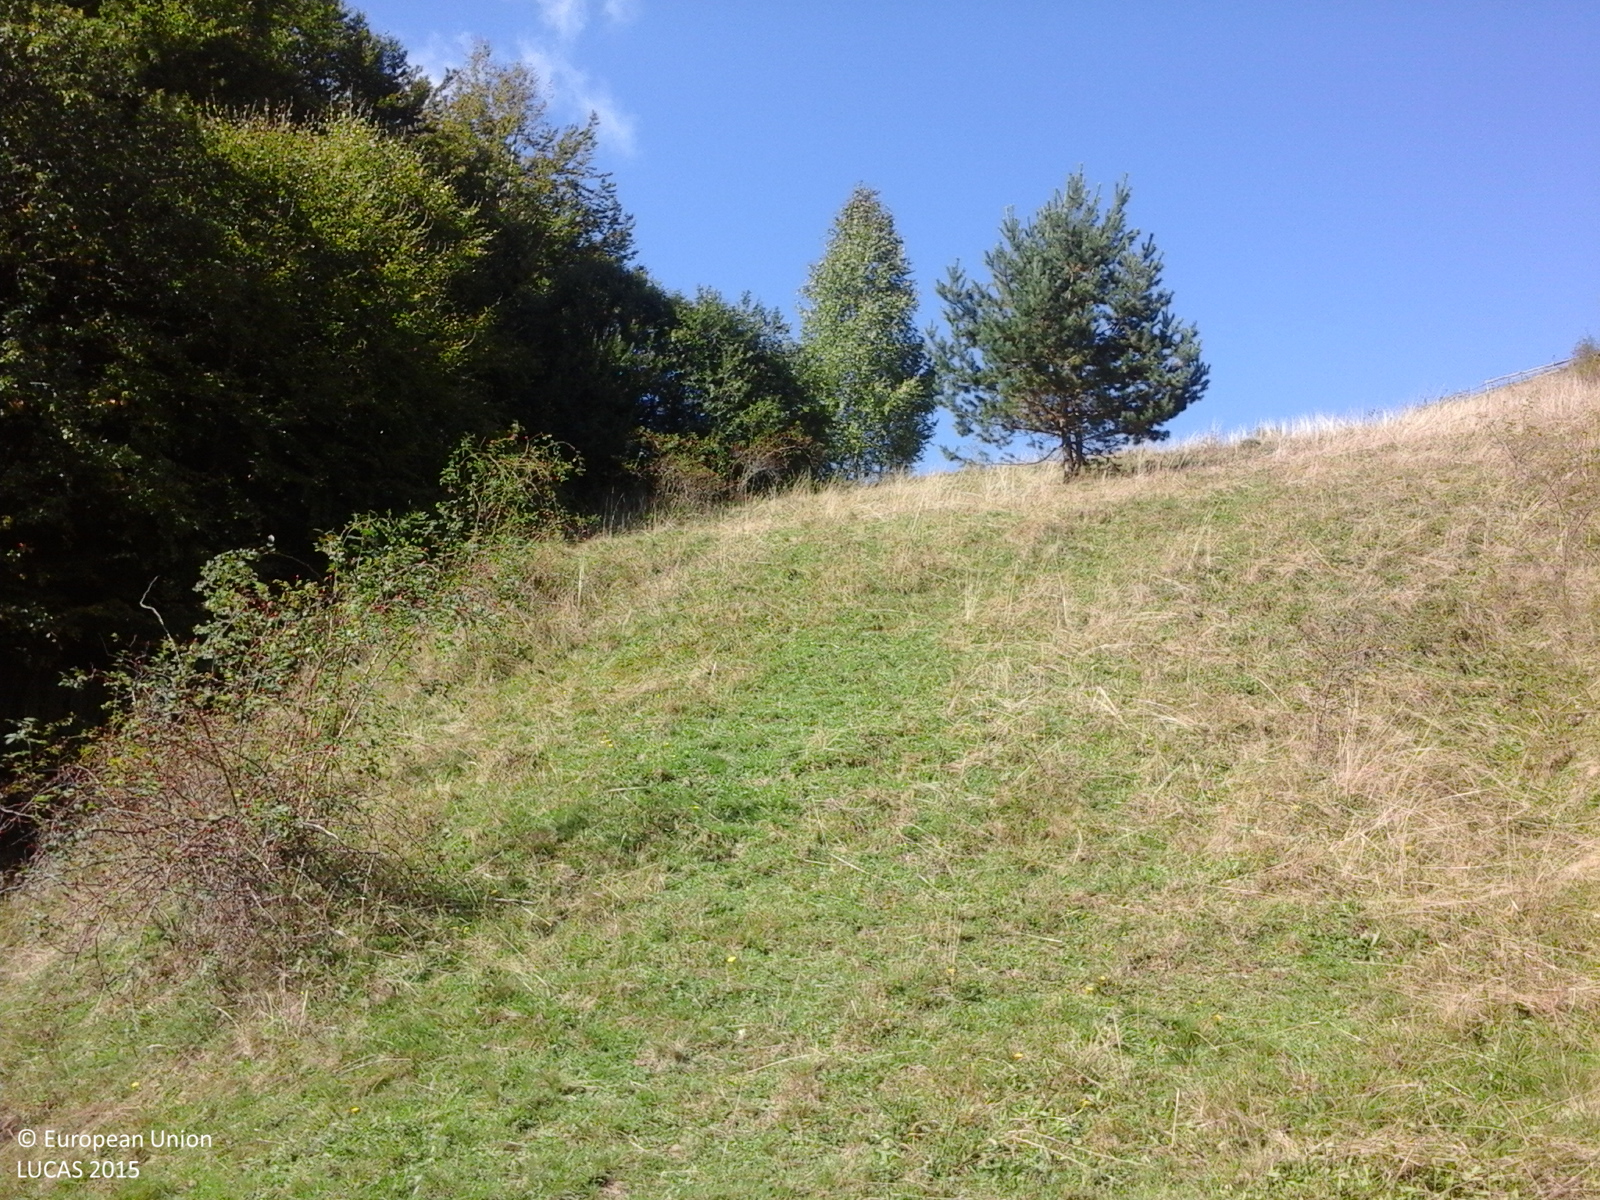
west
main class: Grassland
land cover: Grassland without tree/shrub cover
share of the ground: > 75 %
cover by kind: herbaceous plants 100 %
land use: Agriculture (excluding fallow land and kitchen gardens)
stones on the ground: < 10 %
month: October
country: RO
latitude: 46.4092
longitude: 23.1610
